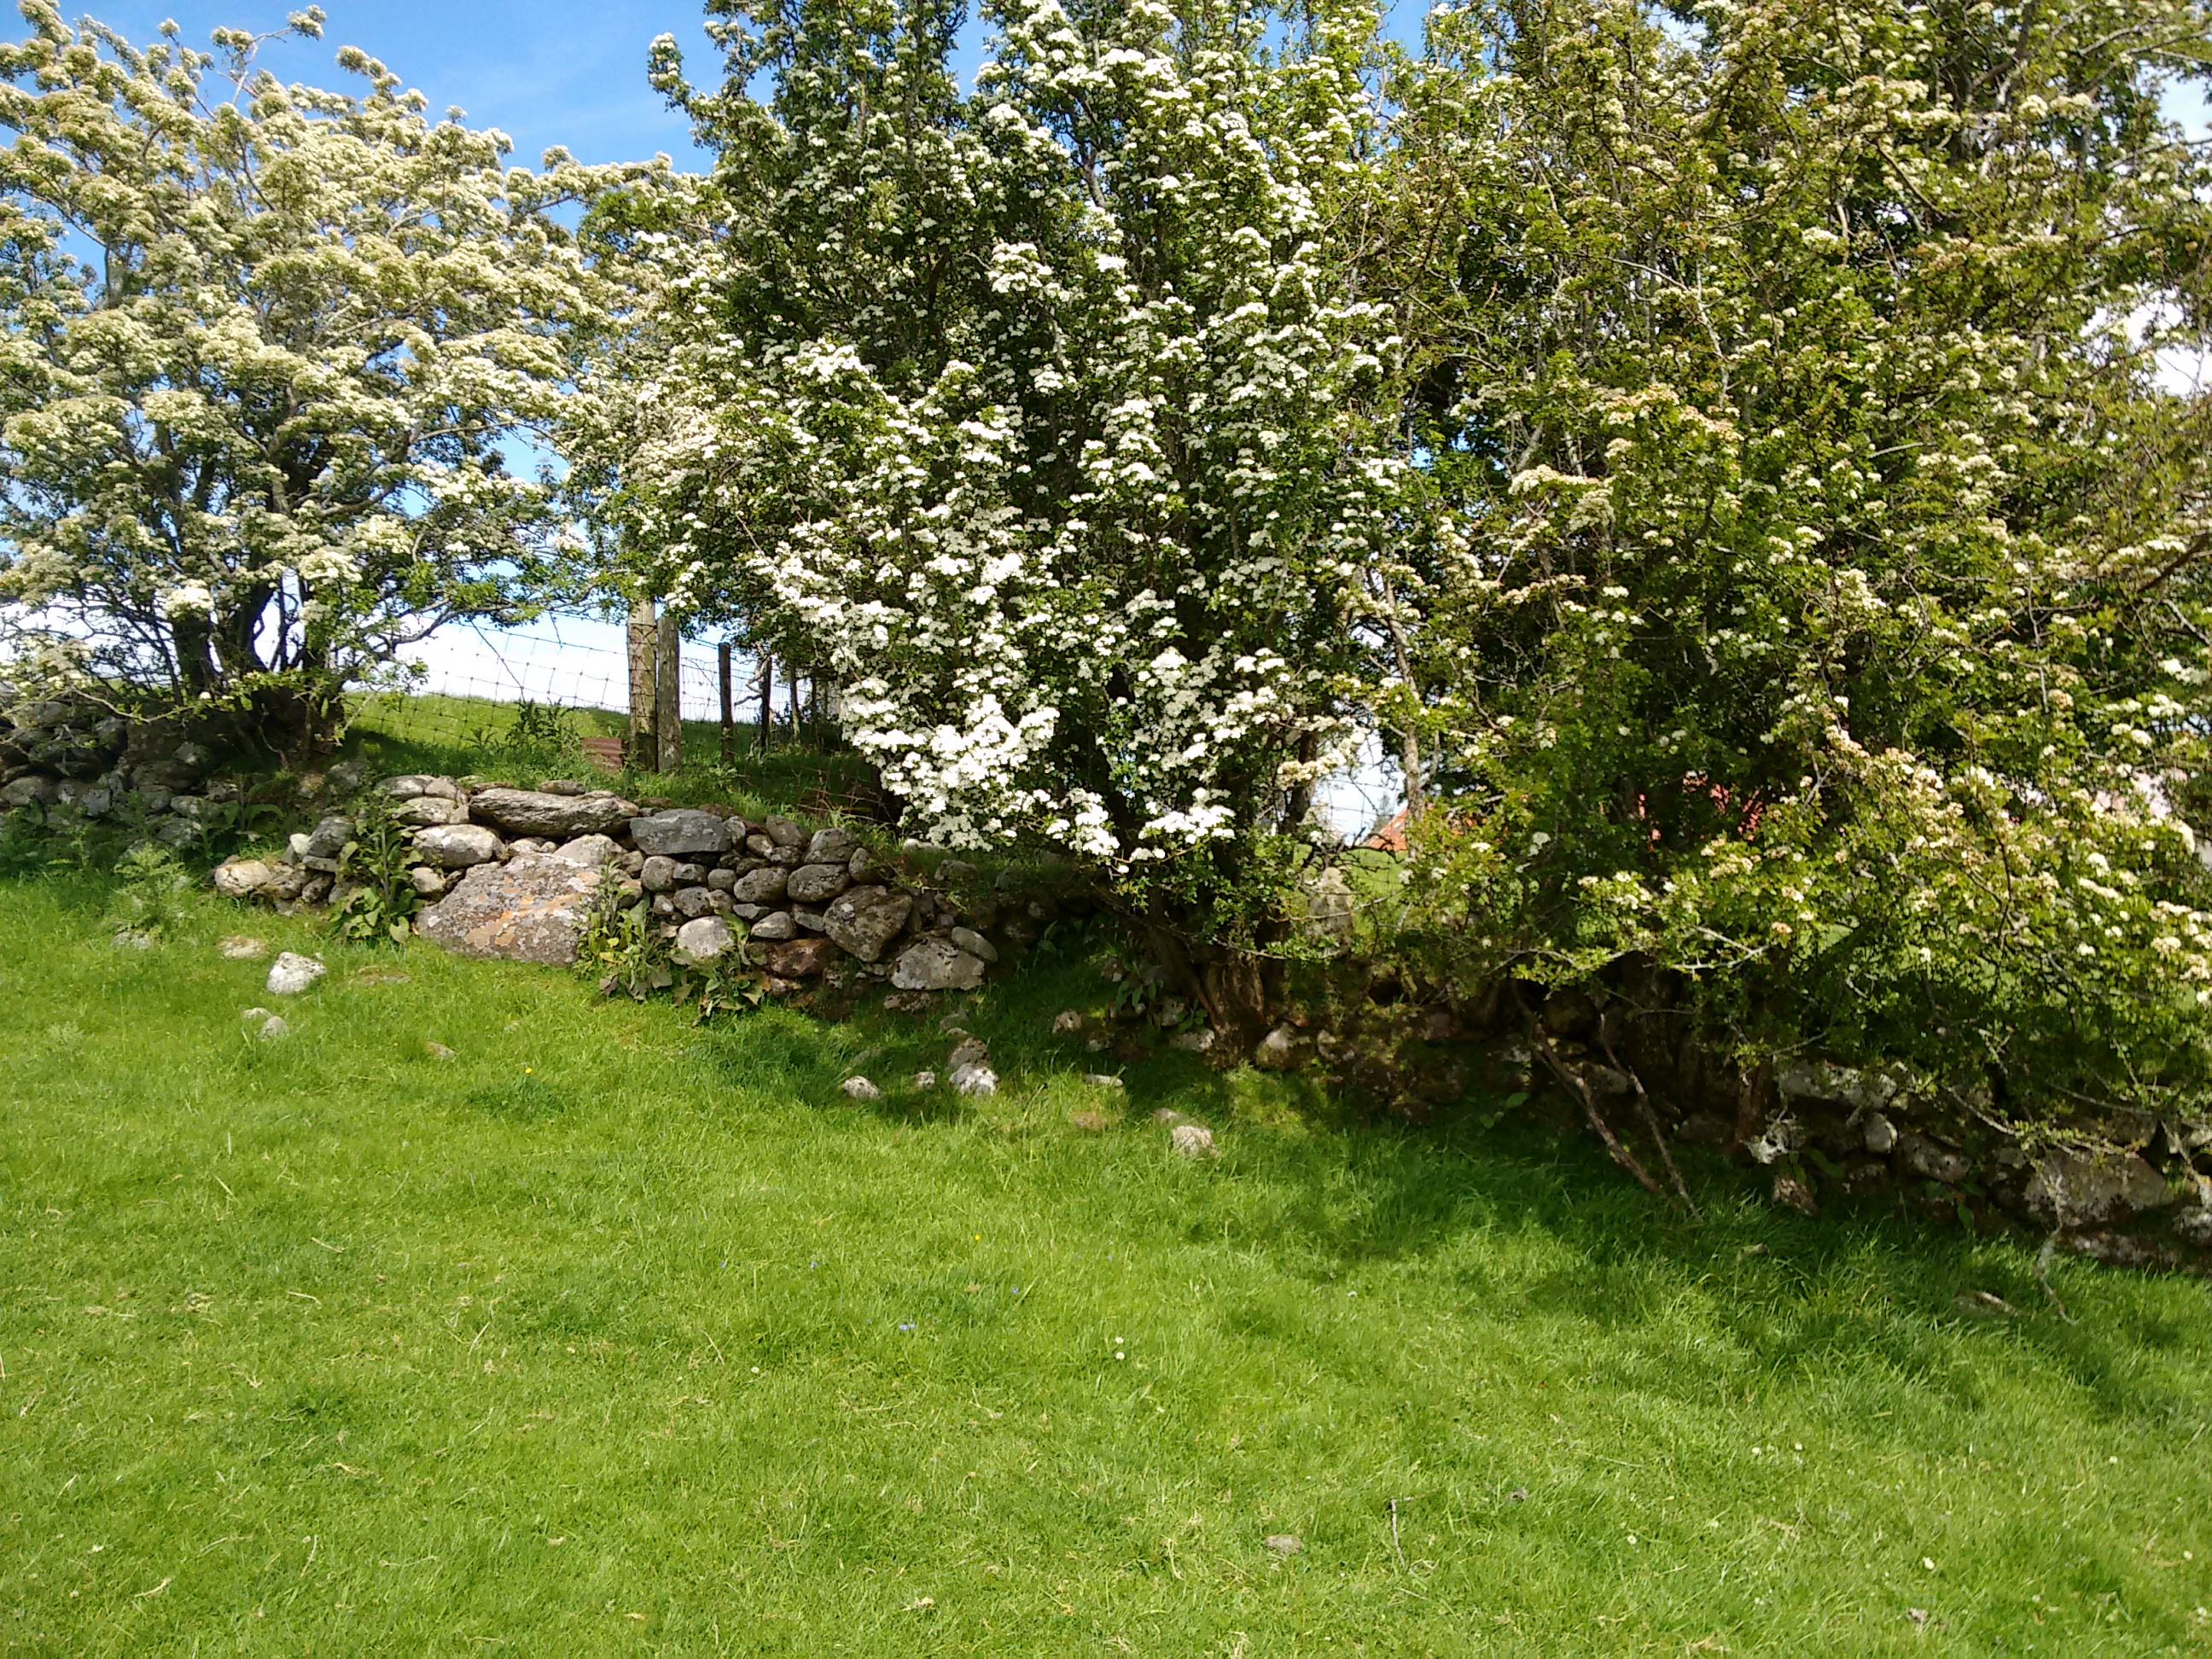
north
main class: Grassland
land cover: Grassland without tree/shrub cover
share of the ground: > 75 %
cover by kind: herbaceous plants 100 %
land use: Agriculture (excluding fallow land and kitchen gardens)
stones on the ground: 25 - 50 %
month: June
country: GB
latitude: 54.8724
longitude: -7.0158
